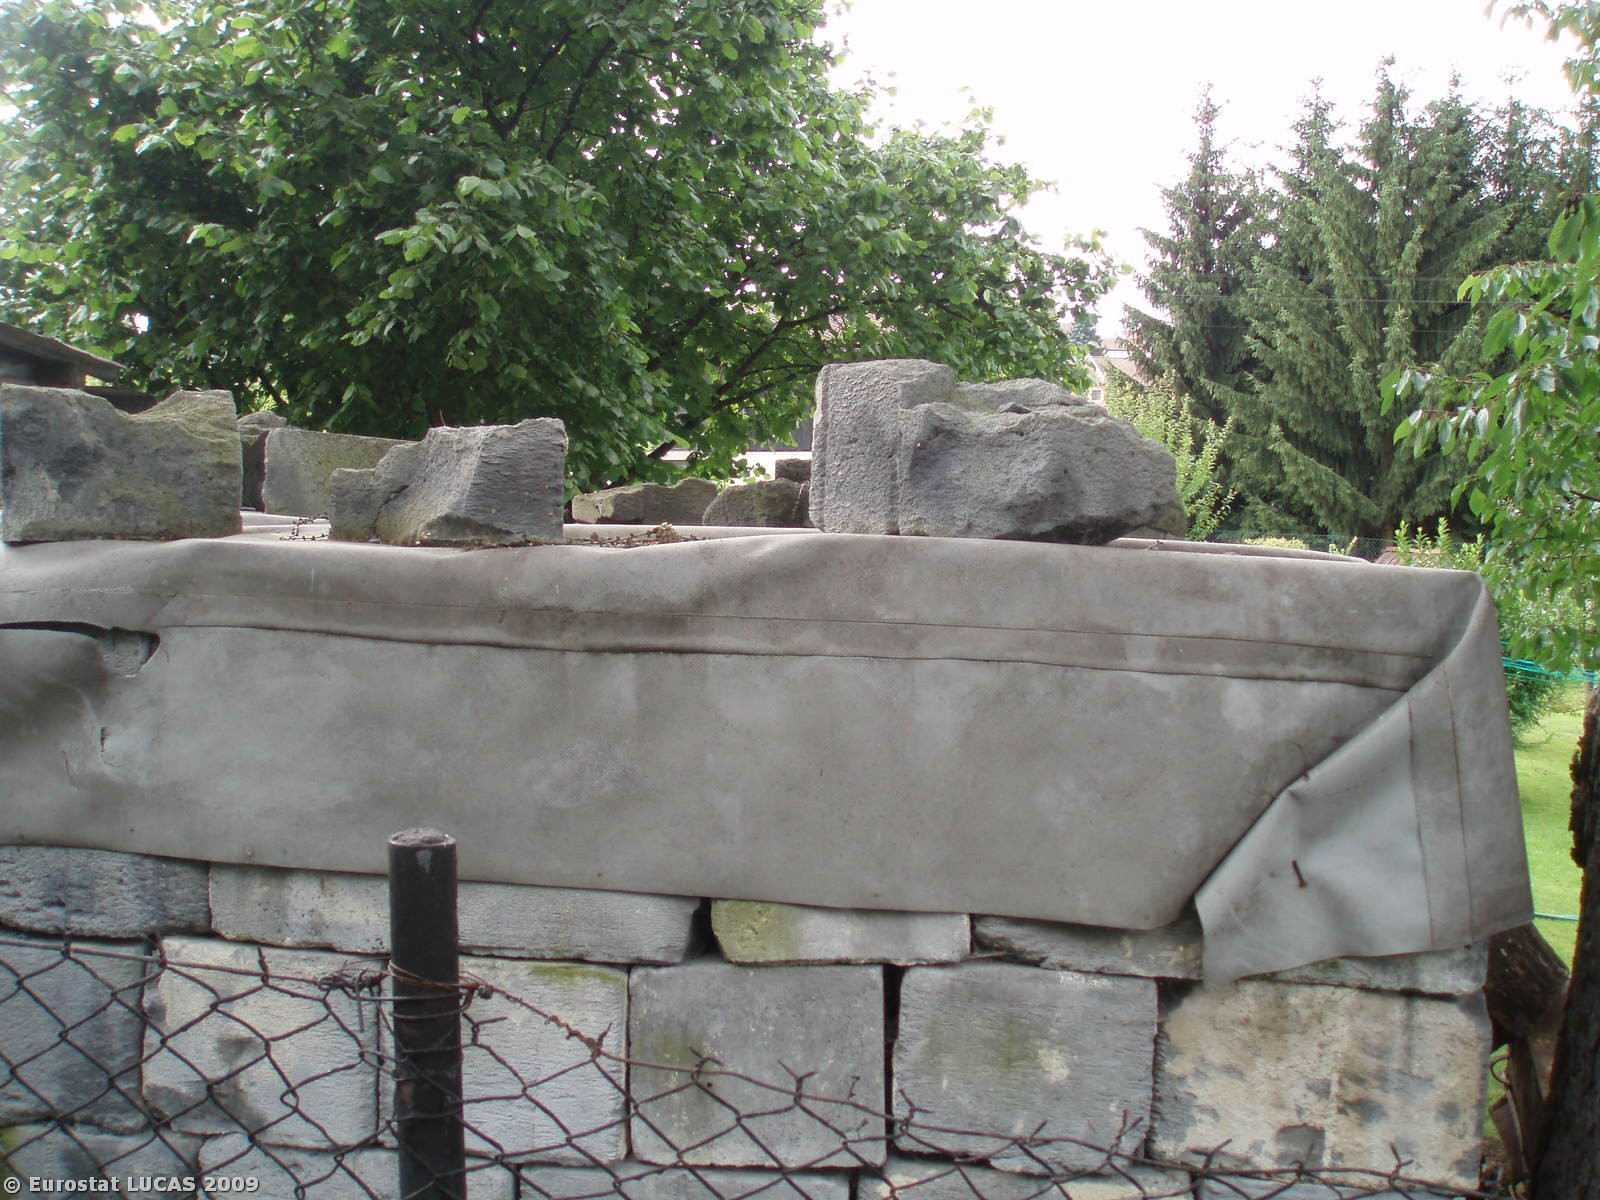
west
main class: Woodland
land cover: Mixed woodland
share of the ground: 50 - 75 %
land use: Residential
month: July
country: CZ
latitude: 50.7372
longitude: 15.0900
